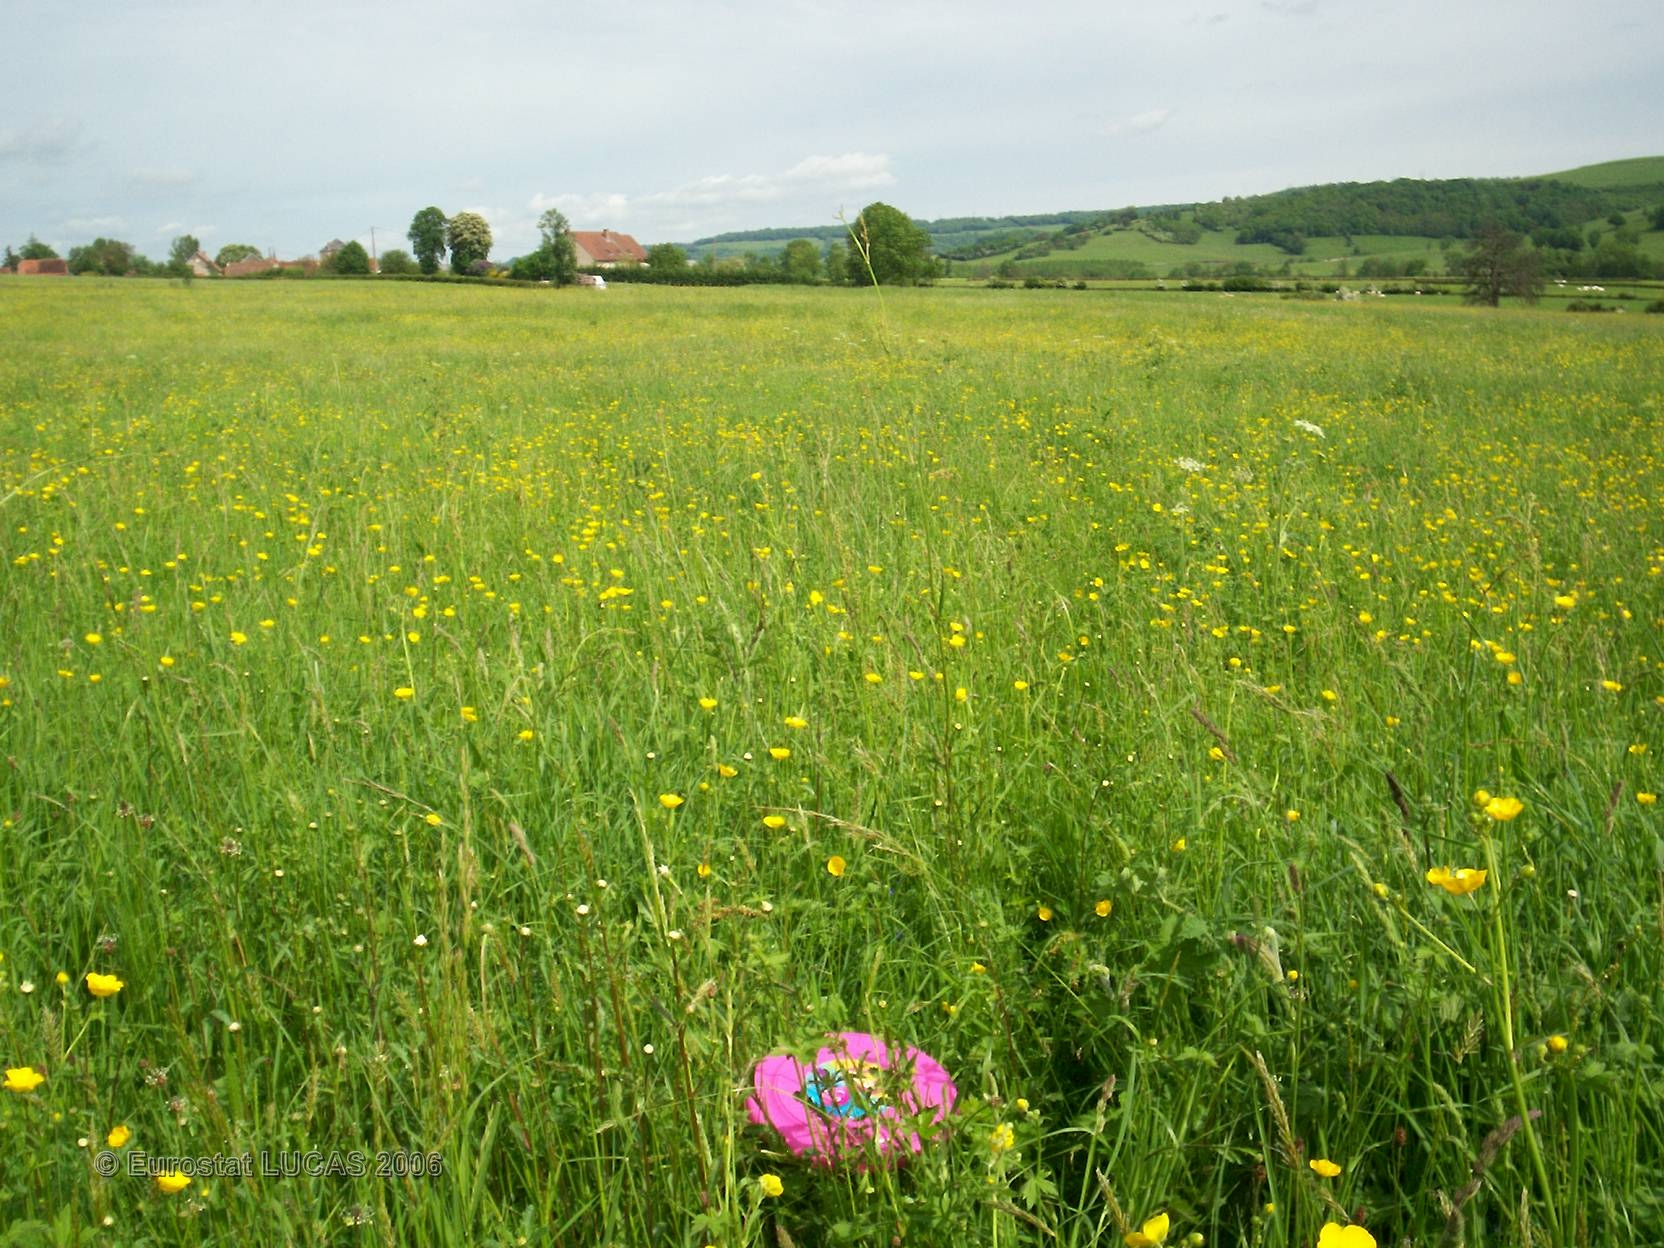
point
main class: Grassland
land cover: Grassland without tree/shrub cover
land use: Agriculture (excluding fallow land and kitchen gardens)
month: May
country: FR
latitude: 47.3676
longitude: 4.5570
